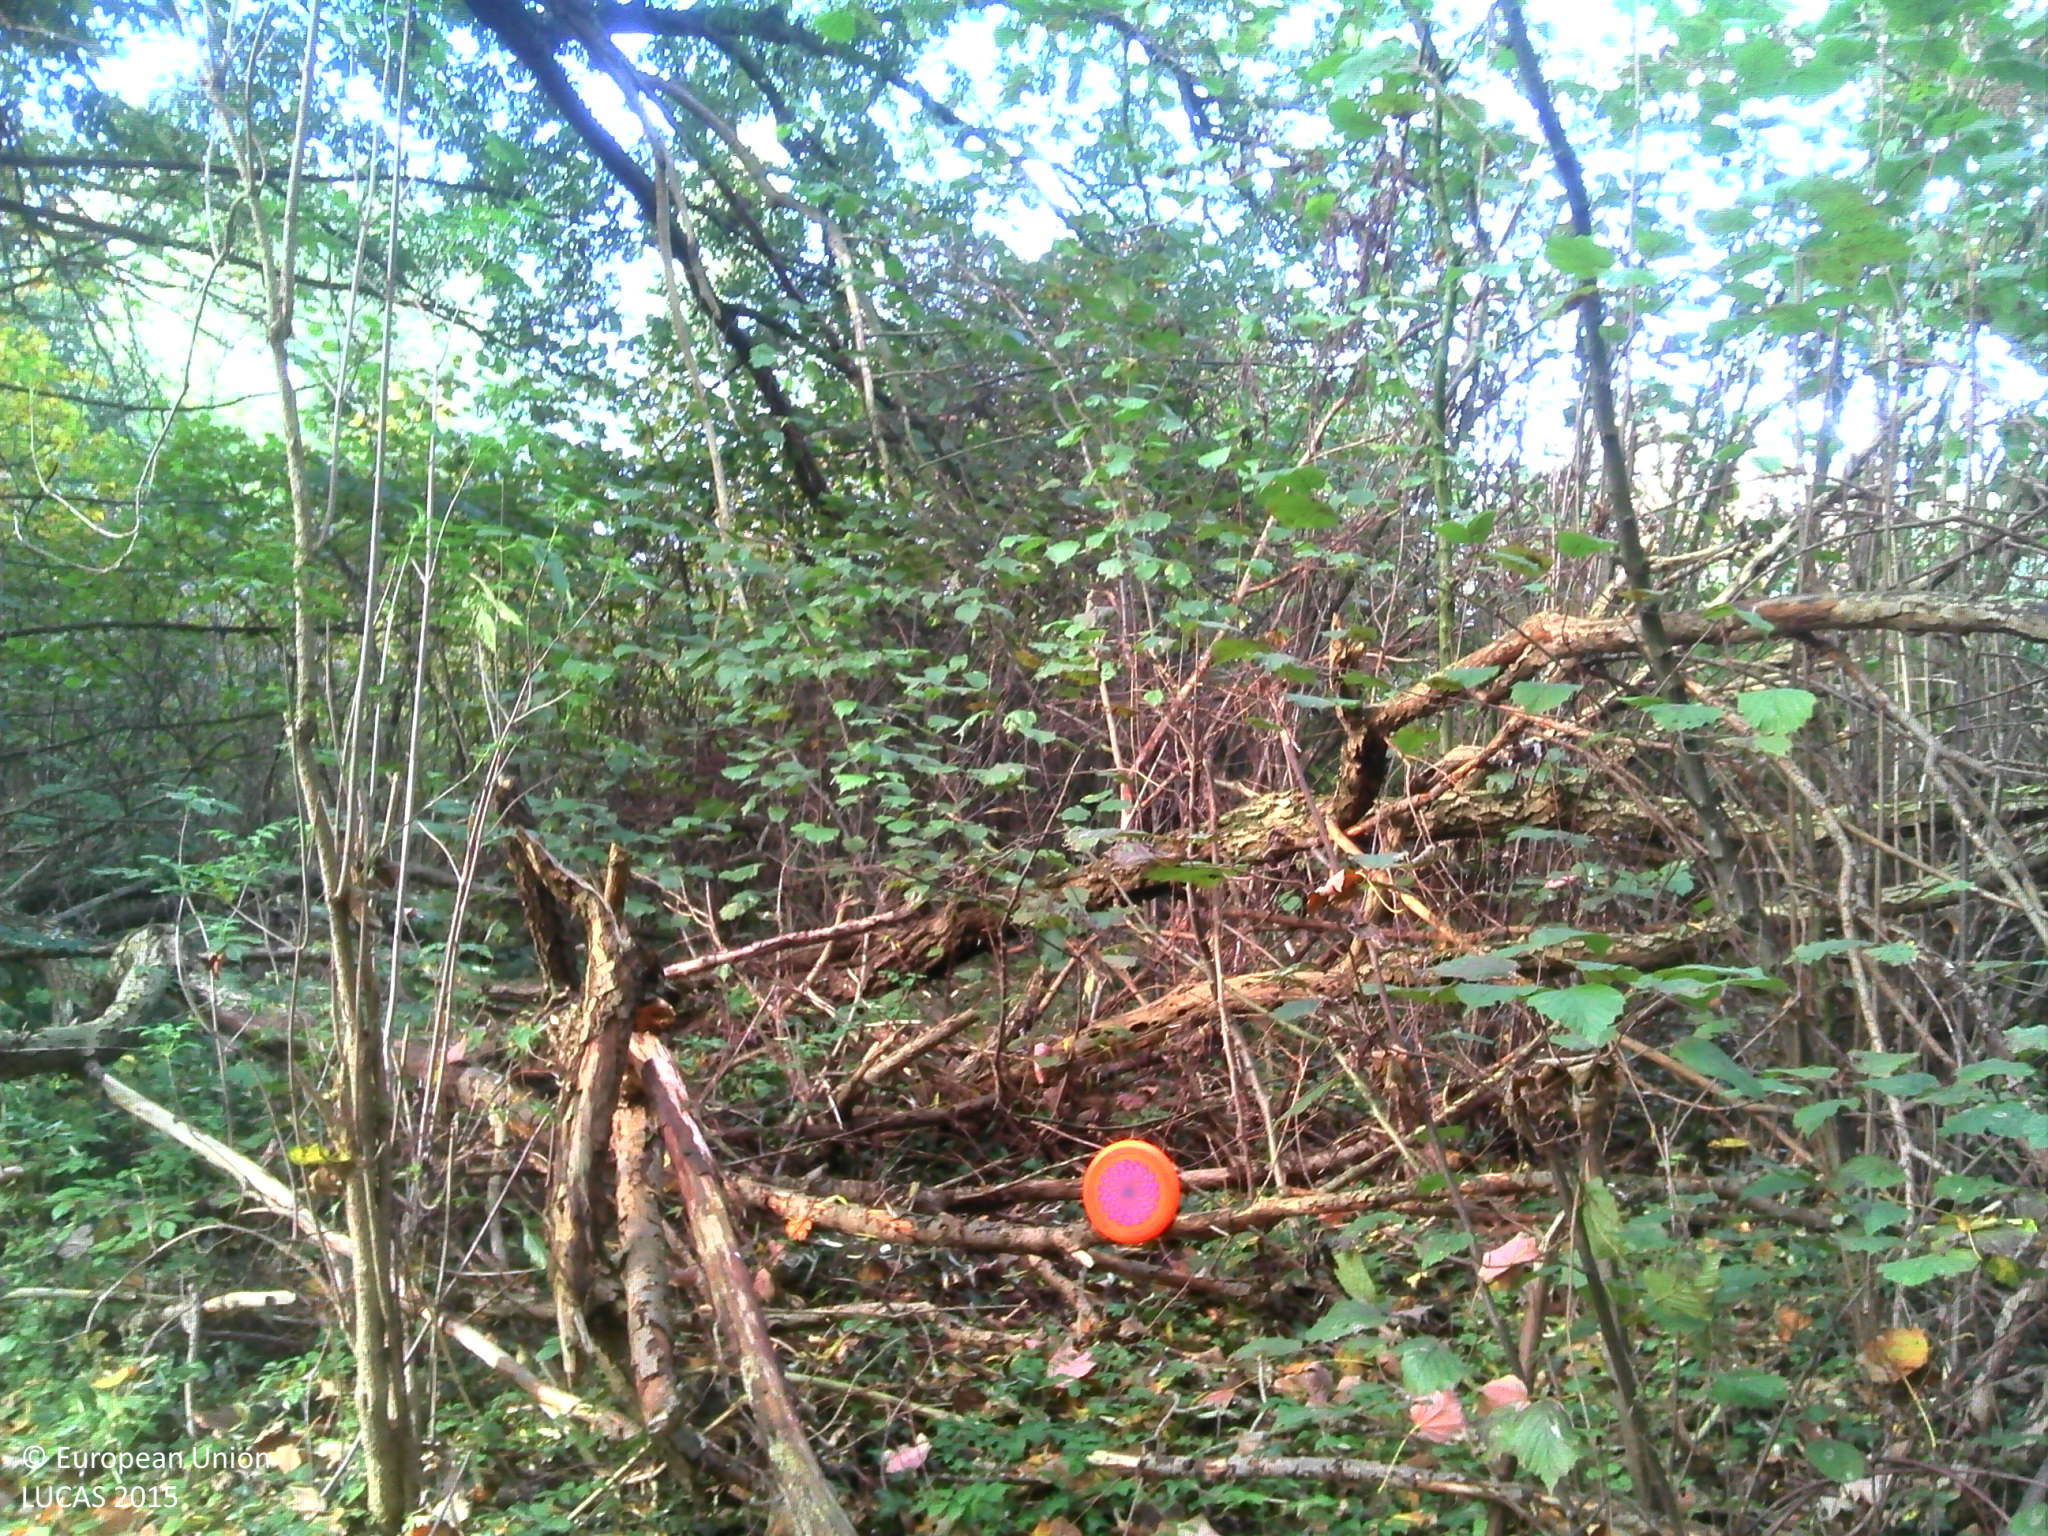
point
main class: Woodland
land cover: Broadleaved woodland
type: mesophytic deciduous forest
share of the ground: > 75 %
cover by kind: broadleaved forest trees 90 %, shrubs 5 %, herbaceous plants 5 %
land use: Amenities, museums, leisure
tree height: > 5 m
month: October
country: BE
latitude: 50.8790
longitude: 4.4669
